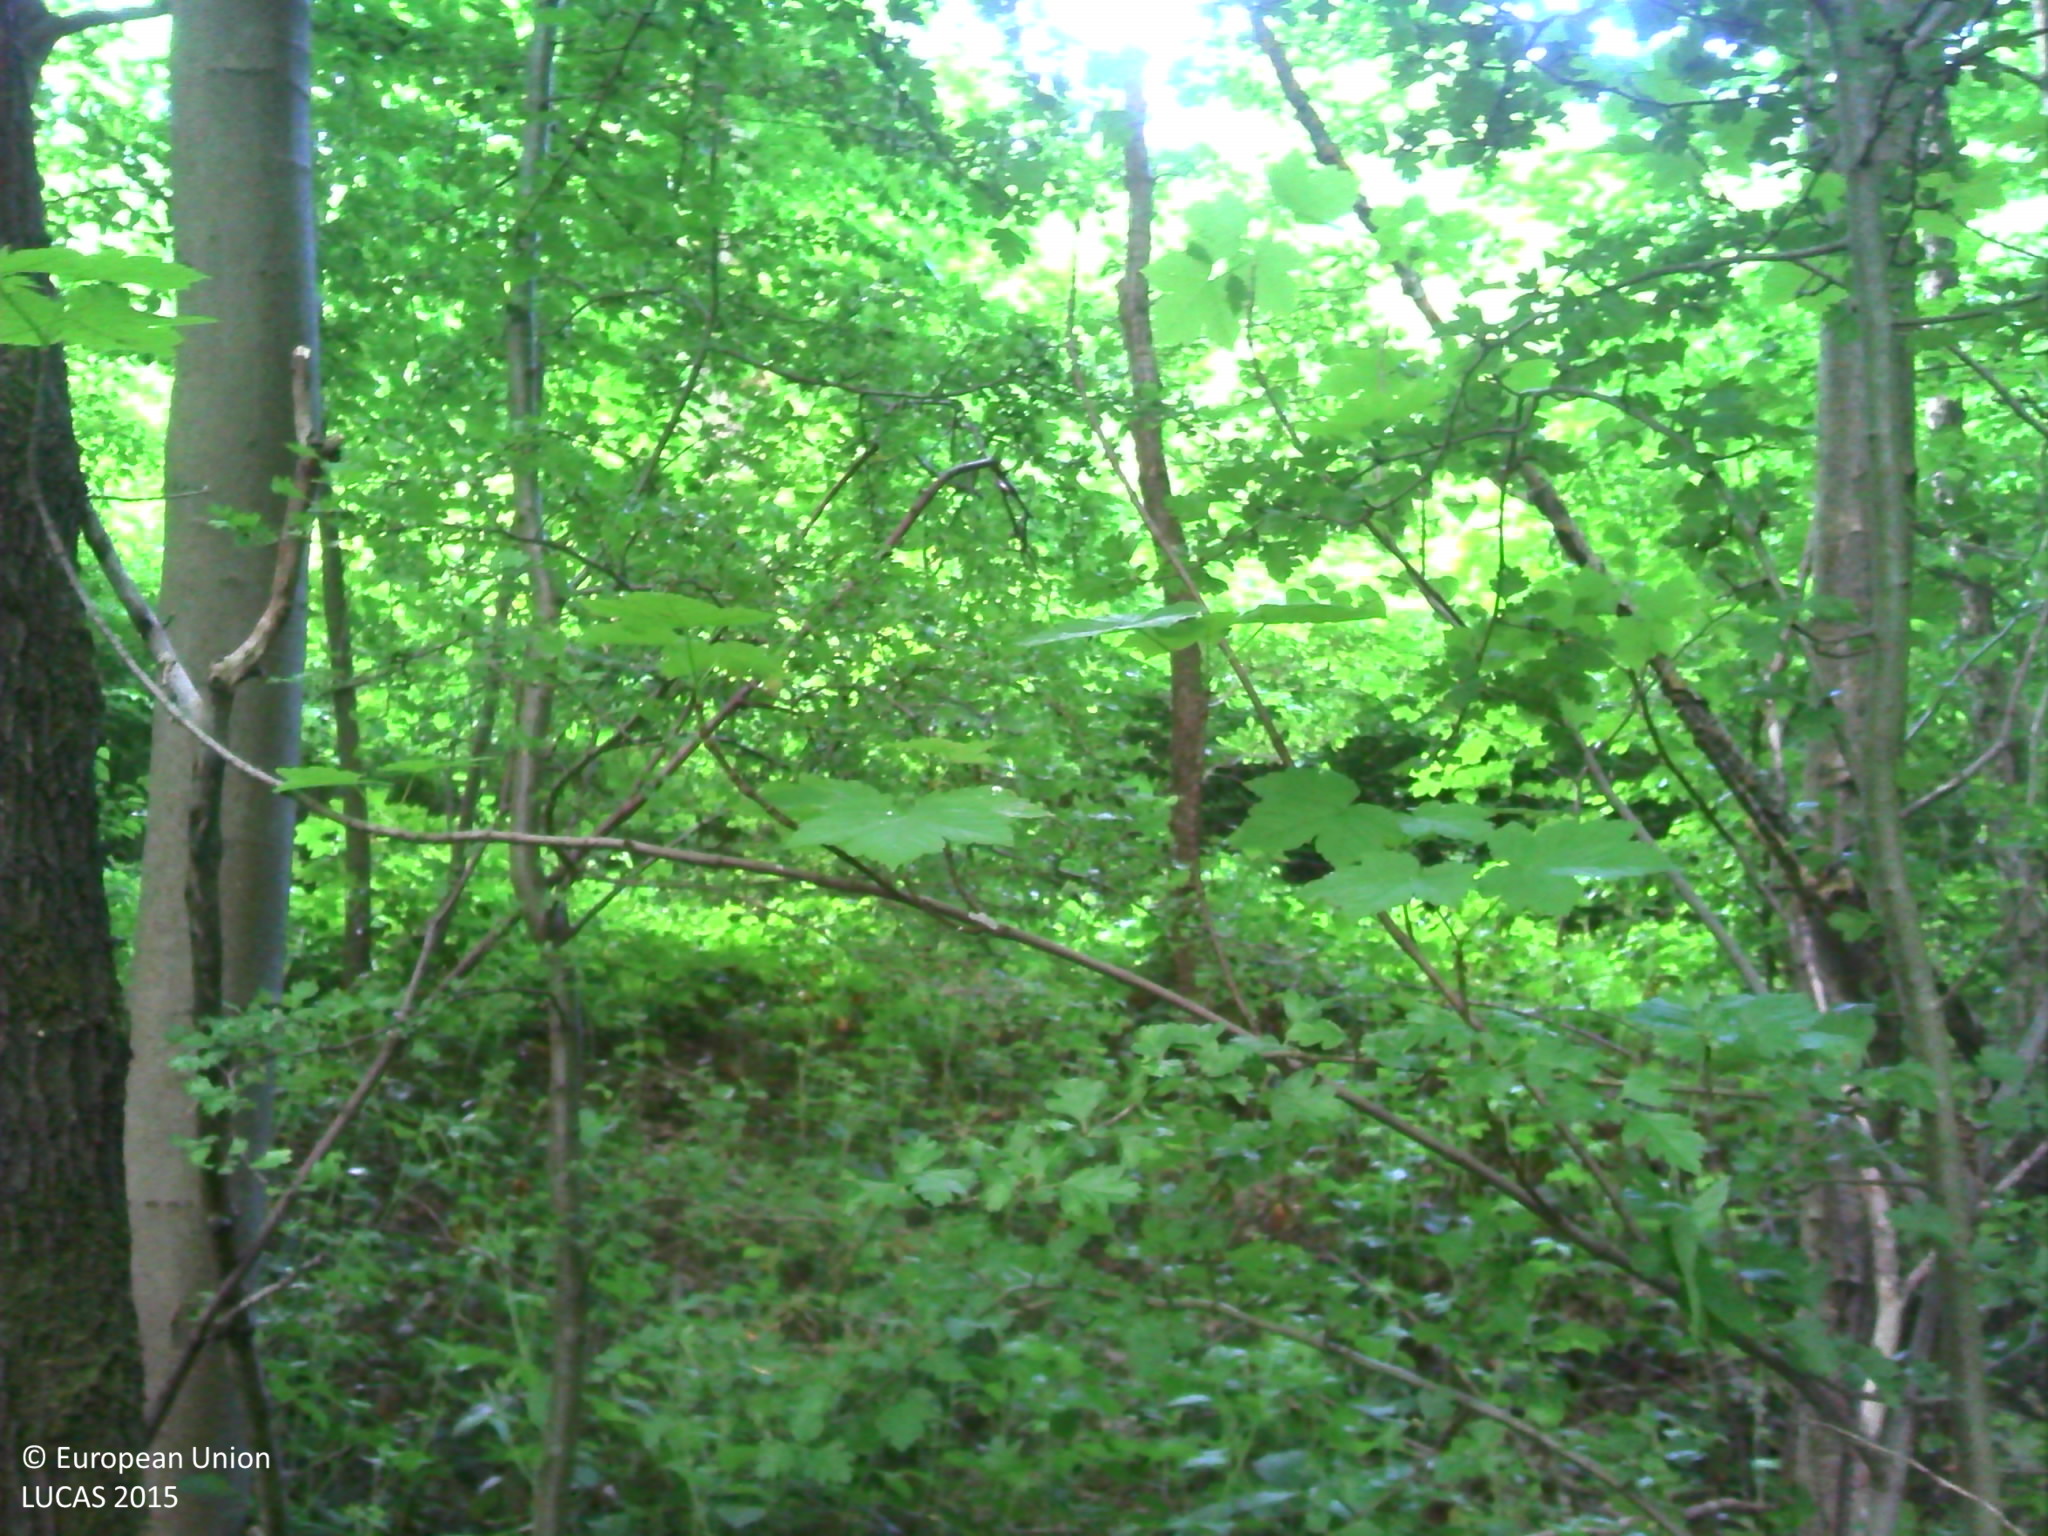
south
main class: Woodland
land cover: Broadleaved woodland
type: mesophytic deciduous forest
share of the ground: > 75 %
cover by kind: broadleaved forest trees 80 %, herbaceous plants 10 %, lichens and mosses 5 %
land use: Forestry
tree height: > 5 m
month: May
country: BE
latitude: 50.3761
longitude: 4.8926
